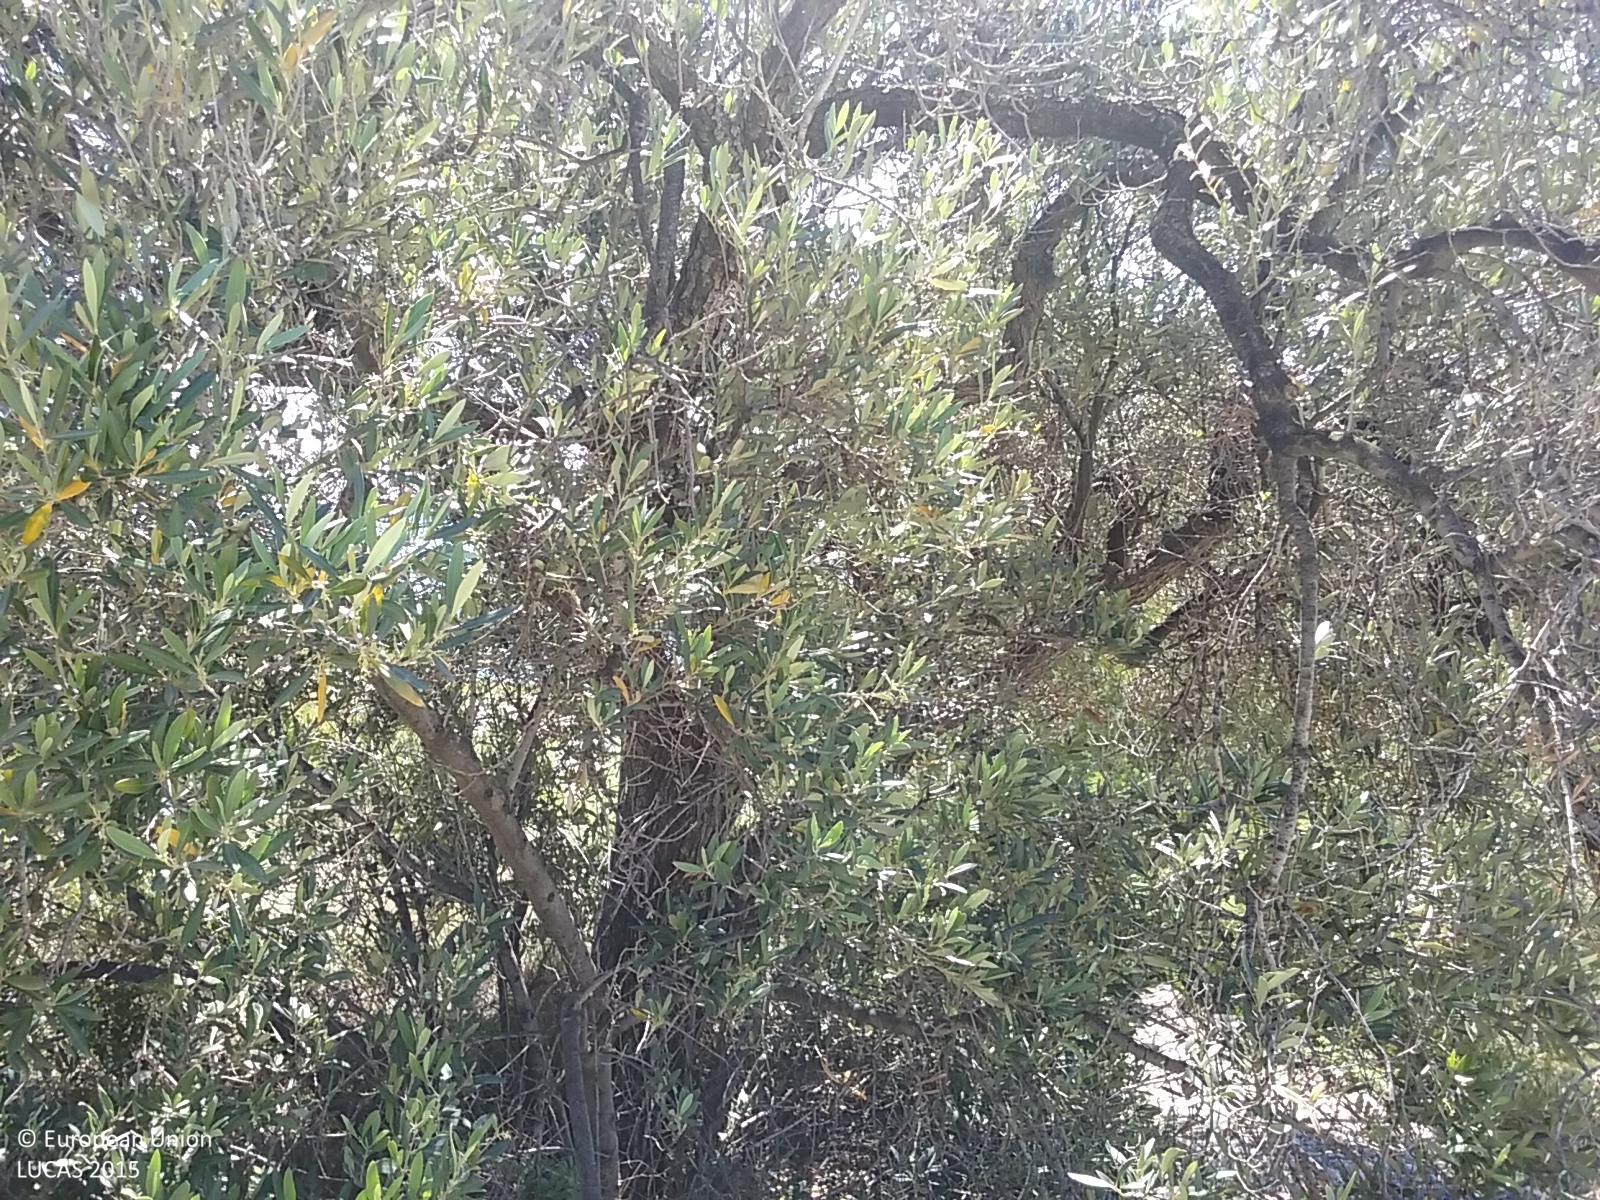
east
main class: Shrubland
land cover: Shrubland with sparse tree cover
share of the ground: 25 - 50 %
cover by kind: herbaceous plants 40 %, shrubs 20 %, coniferous forest trees 5 %
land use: Semi-natural and natural areas not in use
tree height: > 5 m
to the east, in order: Shrubland with sparse tree cover; Dry stone walls; Shrubland with sparse tree cover; Dry stone walls; Shrubland with sparse tree cover; Dry stone walls; Shrubland with sparse tree cover; Dry stone walls; Shrubland with sparse tree cover; Dry stone walls; Shrubland with sparse tree cover; Dry stone walls; Shrubland with sparse tree cover; Dry stone walls; Shrubland with sparse tree cover; Dry stone walls; Shrubland with sparse tree cover; Dry stone walls; Shrubland with sparse tree cover; Dry stone walls; Shrubland with sparse tree cover; Dry stone walls; Shrubland with sparse tree cover; Dry stone walls; Shrubland with sparse tree cover; Dry stone walls; Shrubland with sparse tree cover; Dry stone walls; Shrubland with sparse tree cover; Dry stone walls; Shrubland with sparse tree cover; Dry stone walls; Shrubland with sparse tree cover; Dry stone walls; Permanent industrial crops; Dry stone walls; Permanent industrial crops; Dry stone walls; Pine dominated coniferous woodland; Dry stone walls; Shrubland with sparse tree cover; Other bare soil; Tracks; Shrubland without tree cover; Rocks and stones; Intertidal flats; Rocks and stones; Shrubland without tree cover; Rocks and stones
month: May
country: ES
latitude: 40.3195
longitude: 0.3593
